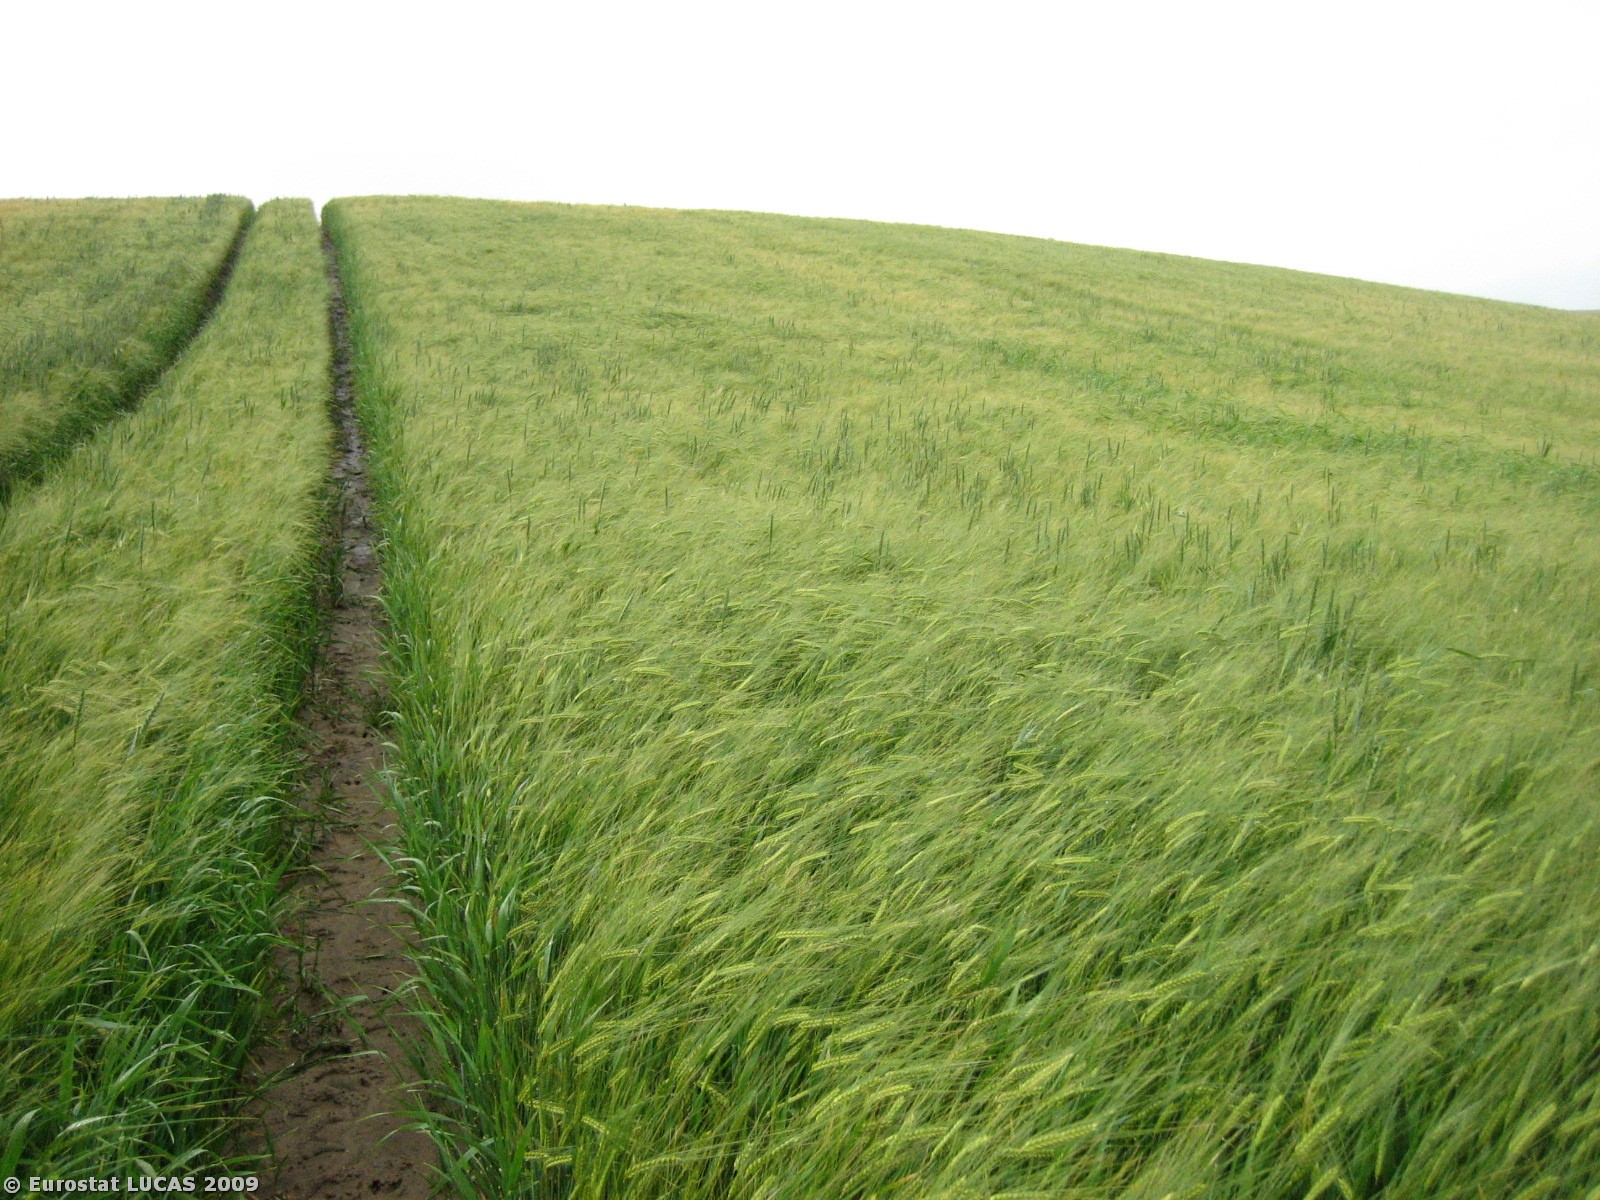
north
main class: Cropland
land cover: Barley
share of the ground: > 75 %
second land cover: Common wheat
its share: < 10 %
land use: Agriculture (excluding fallow land and kitchen gardens)
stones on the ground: < 10 %
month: June
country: DK
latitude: 55.9900
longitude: 10.0160
